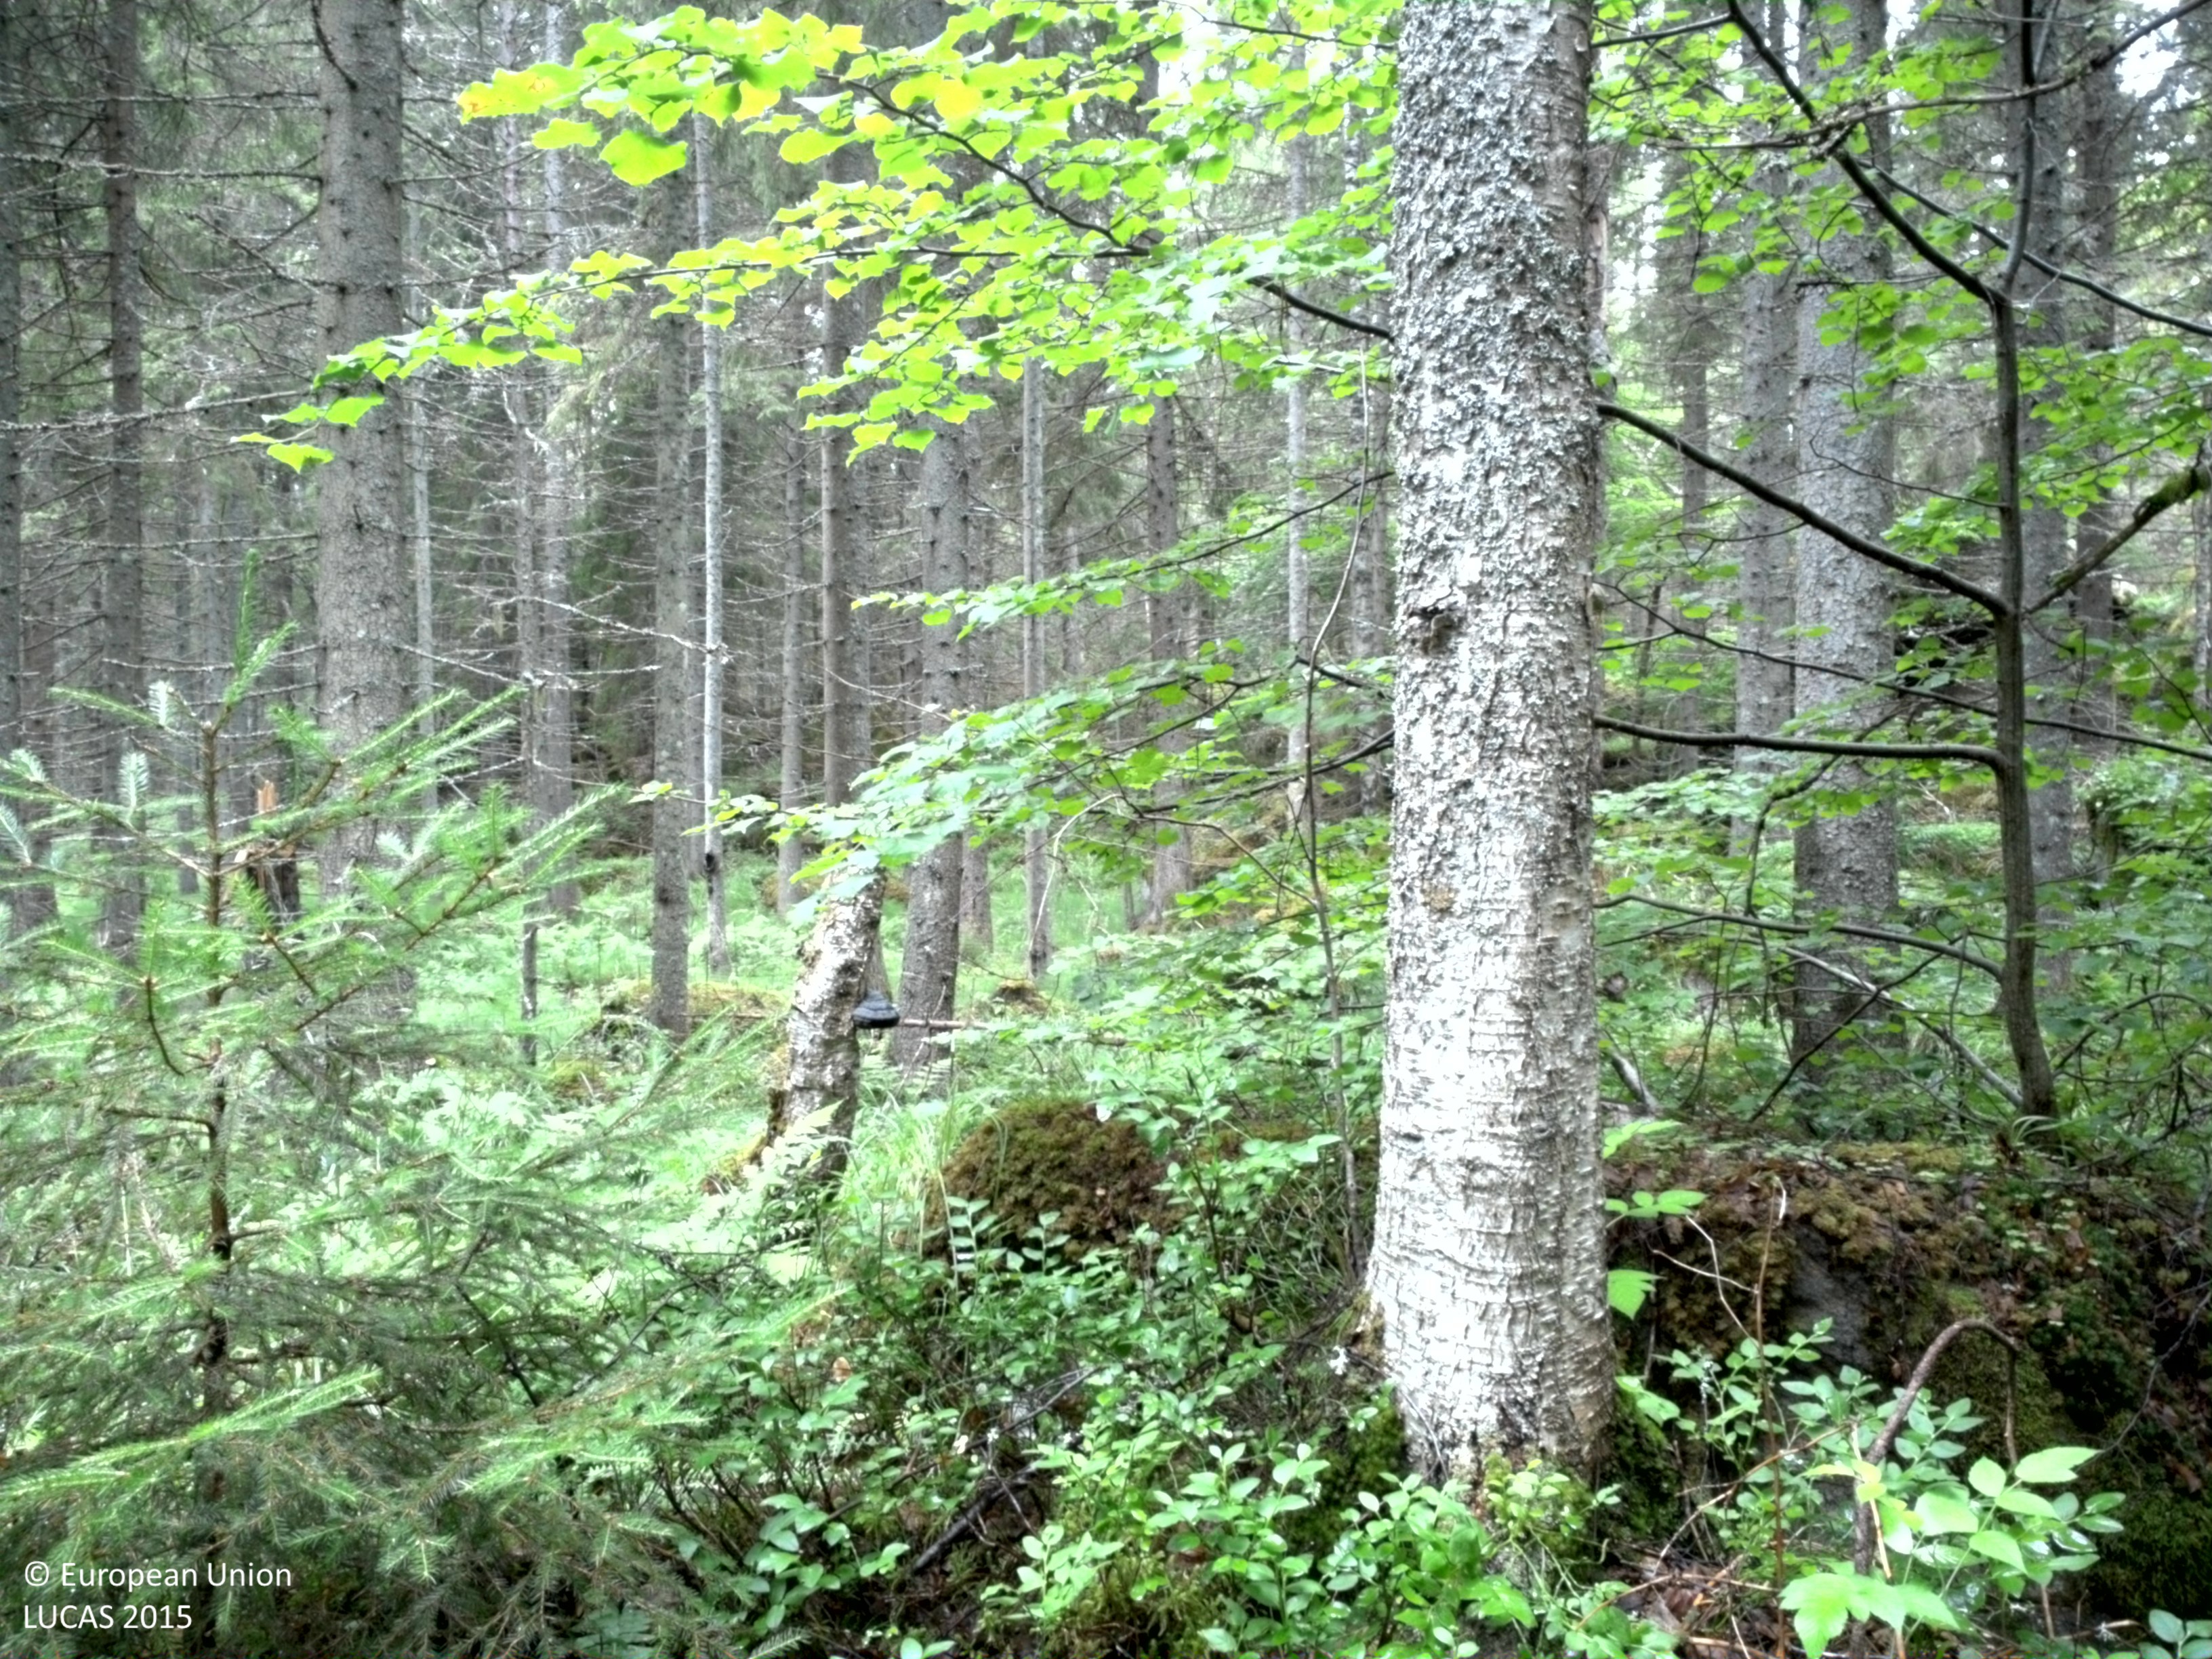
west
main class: Woodland
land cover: Spruce dominated coniferous woodland
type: boreal forest
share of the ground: > 75 %
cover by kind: coniferous forest trees 75 %, herbaceous plants 10 %, lichens and mosses 10 %, broadleaved forest trees 5 %
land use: Forestry
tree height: > 5 m
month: July
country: SE
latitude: 59.9485
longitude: 18.3935
